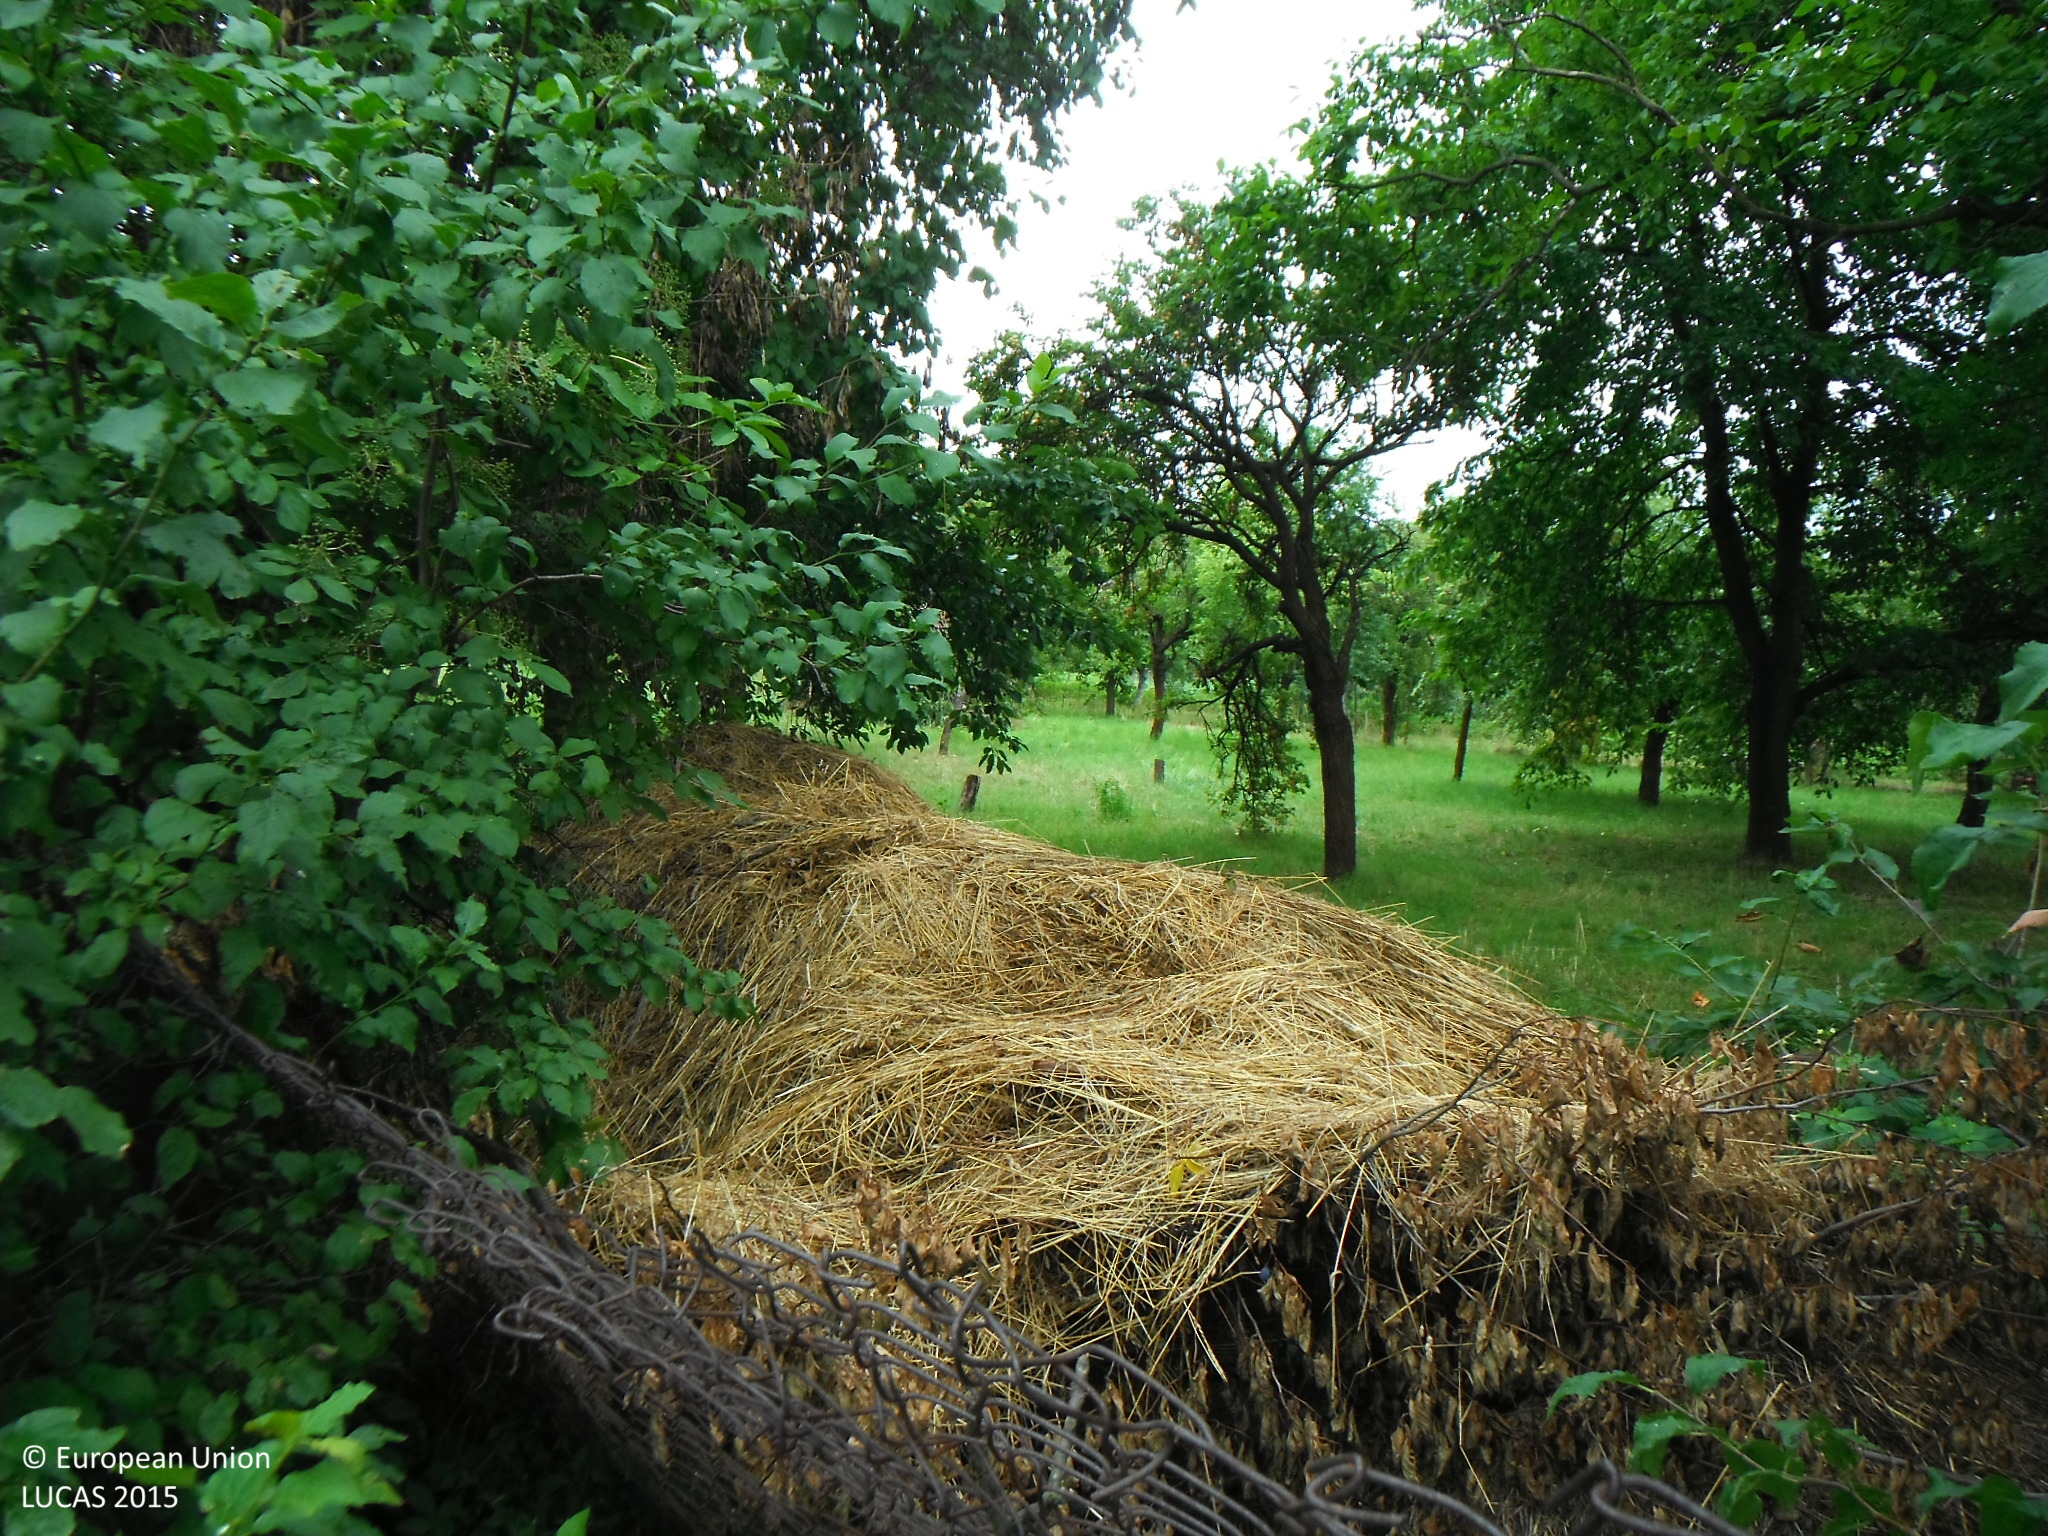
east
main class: Cropland
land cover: Nuts trees
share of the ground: 50 - 75 %
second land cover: Grassland without tree/shrub cover
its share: > 75 %
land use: Kitchen garden
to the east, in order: Nuts trees; Grassland without tree/shrub cover; Artificial constructions in urban areas; Spontaneously vegetated surfaces
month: July
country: SK
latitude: 48.7821
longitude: 21.3278
